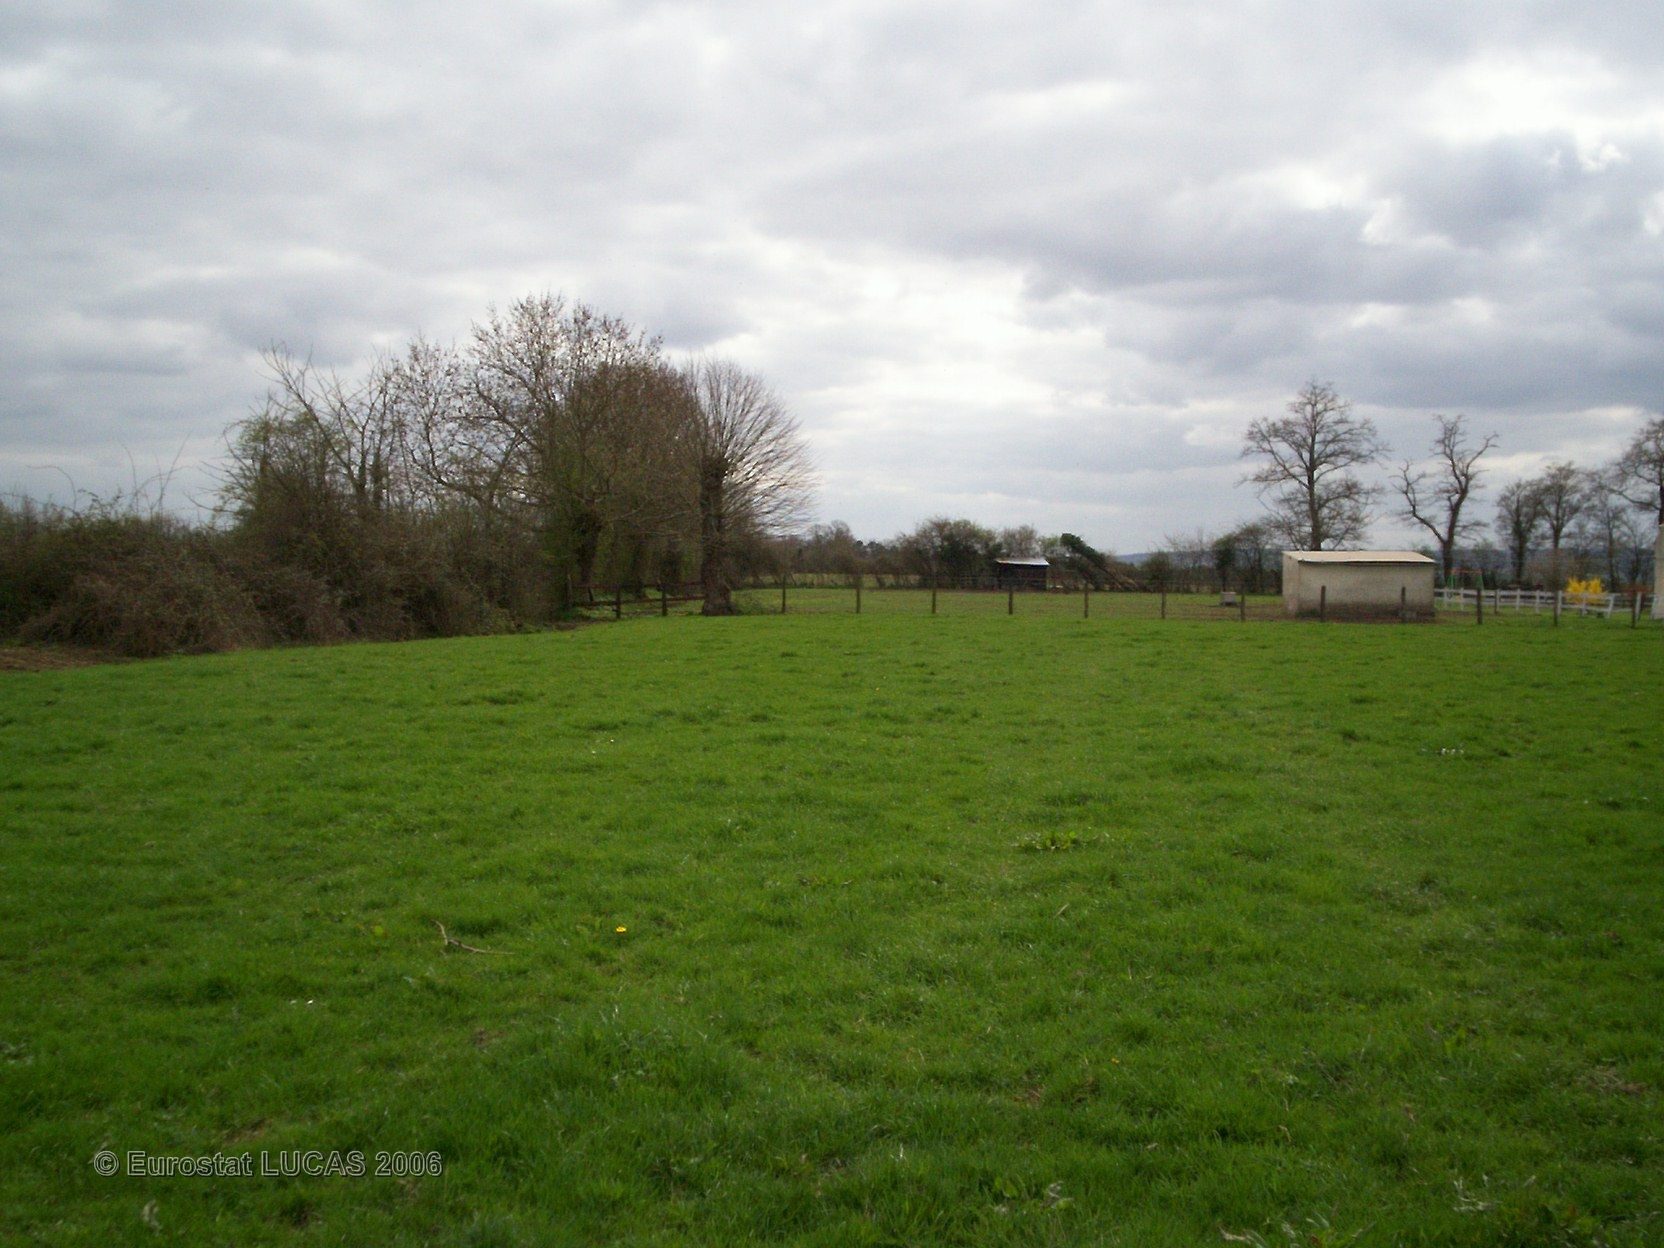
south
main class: Grassland
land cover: Grassland without tree/shrub cover
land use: Agriculture (excluding fallow land and kitchen gardens)
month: April
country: FR
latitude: 48.8455
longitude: 0.0912
